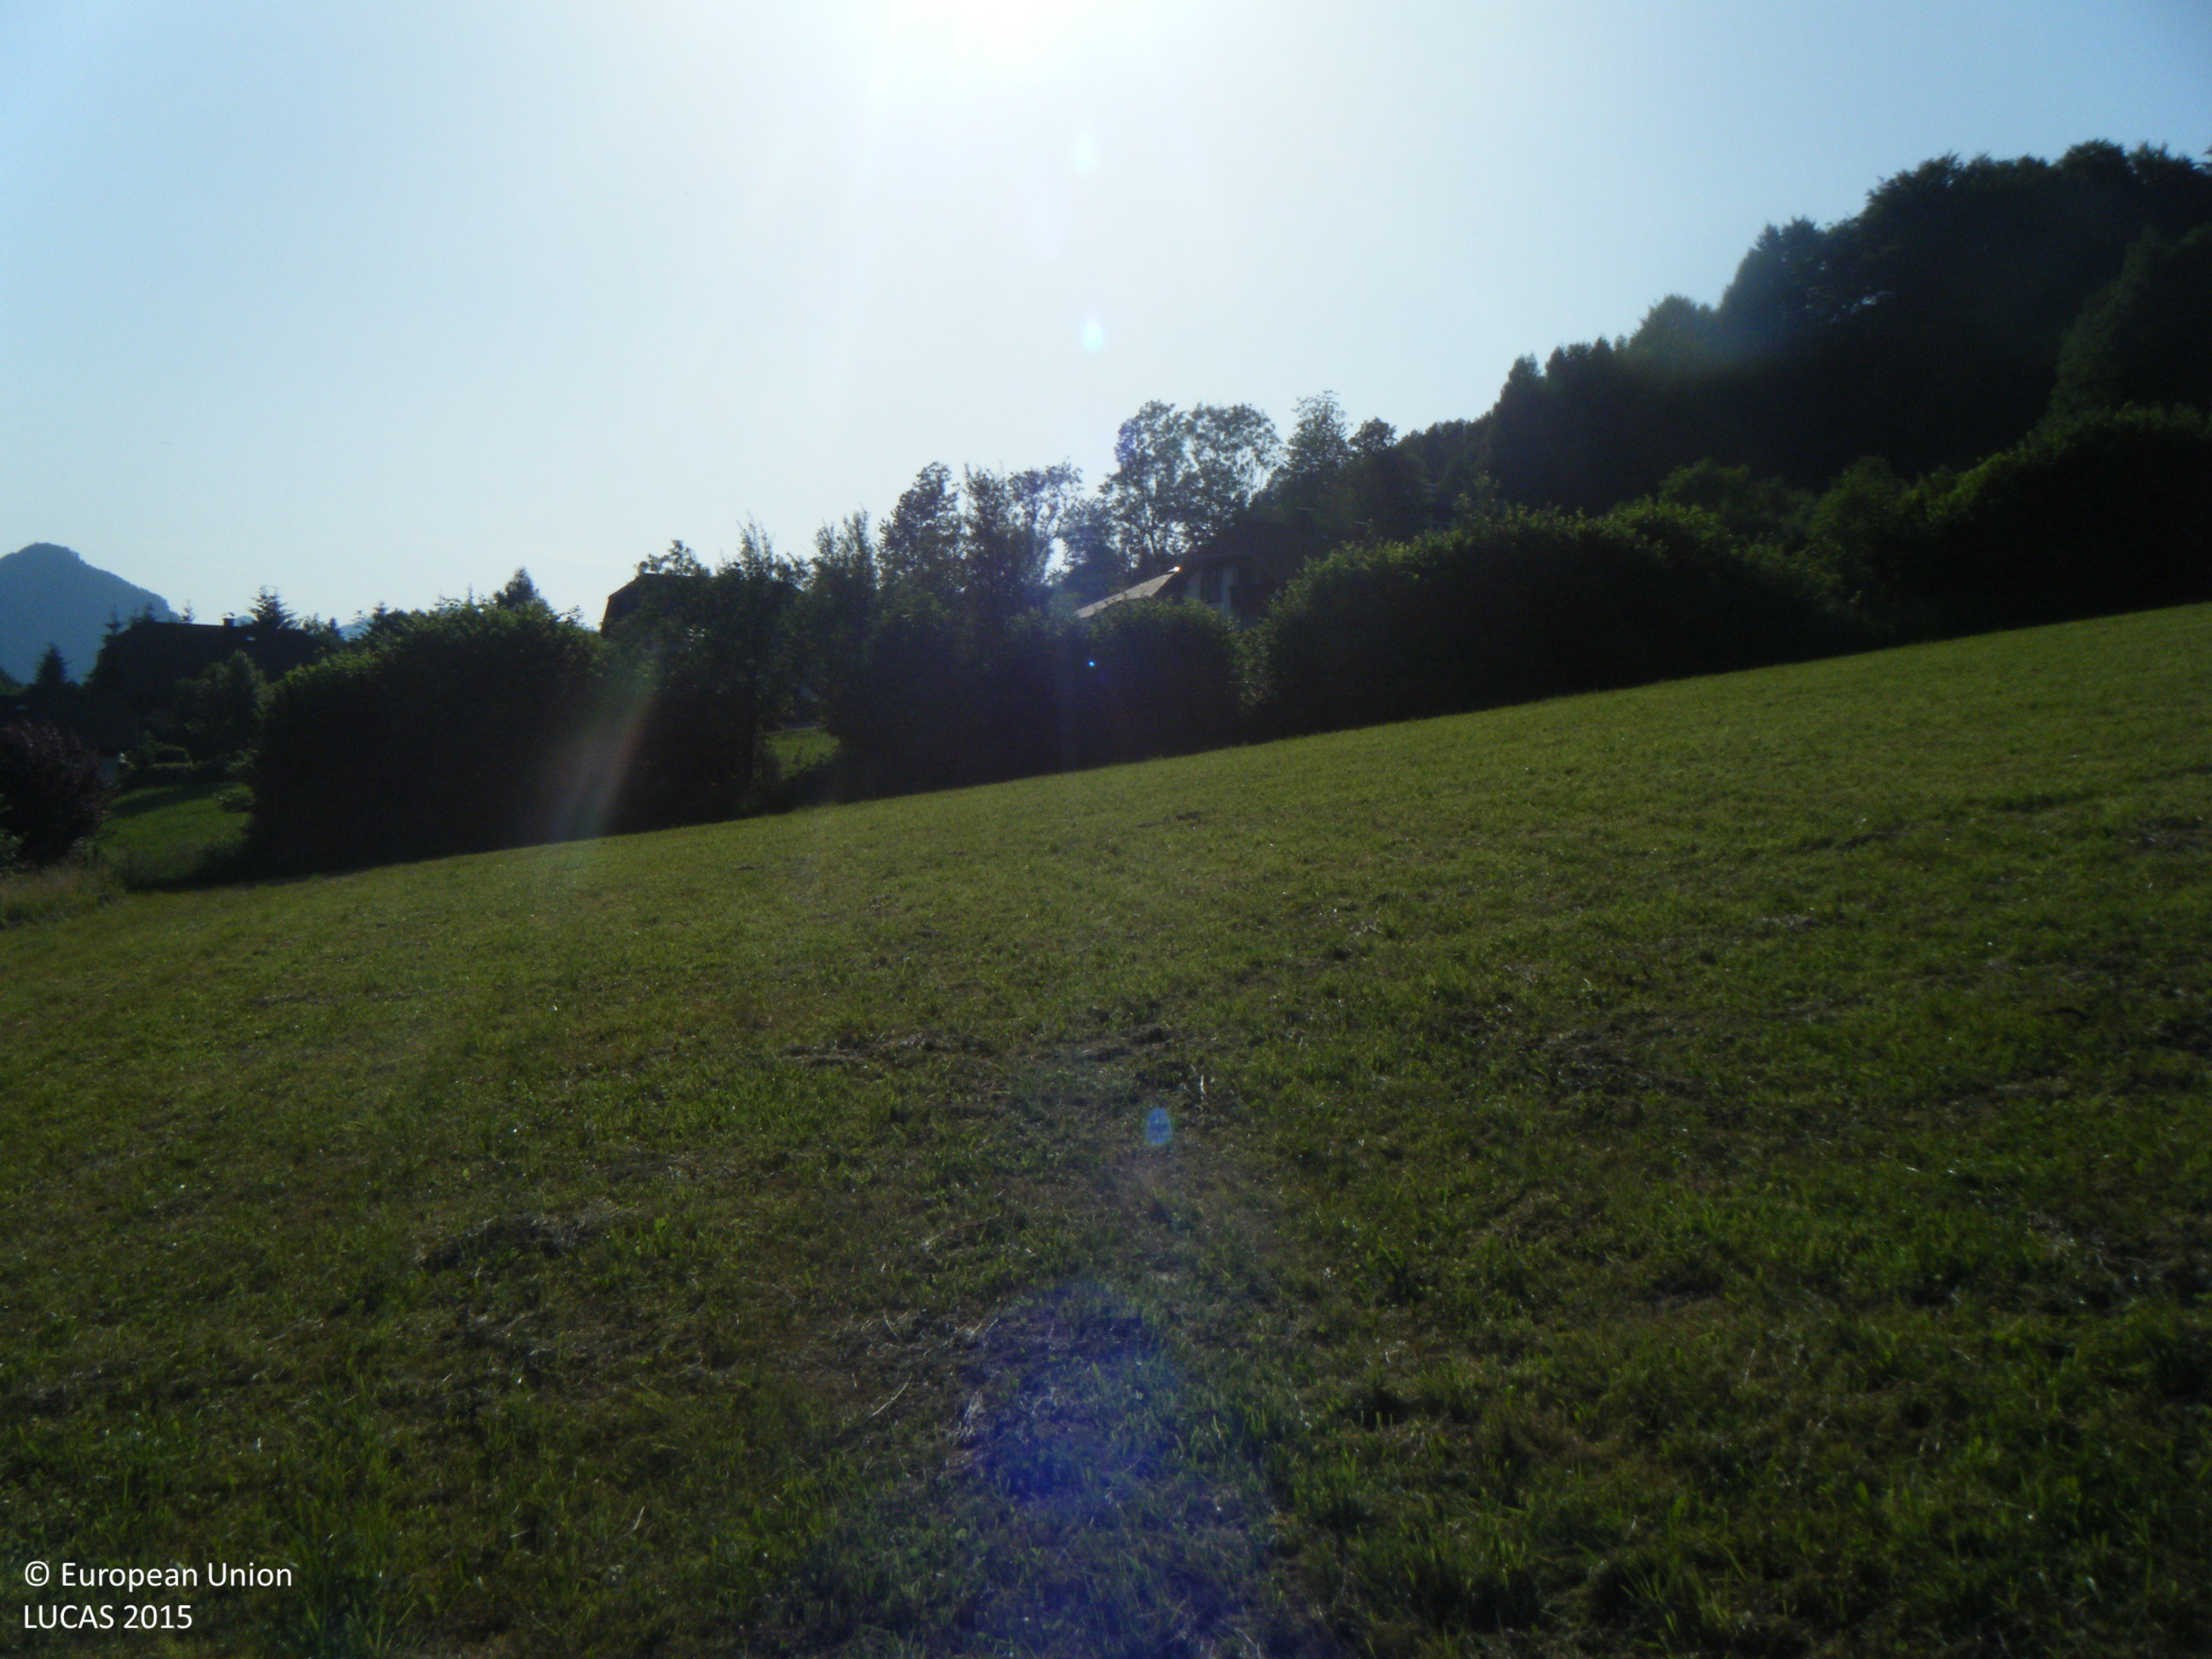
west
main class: Grassland
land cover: Grassland without tree/shrub cover
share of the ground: > 75 %
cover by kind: herbaceous plants 100 %
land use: Agriculture (excluding fallow land and kitchen gardens)
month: July
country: AT
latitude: 47.8083
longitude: 13.4840
